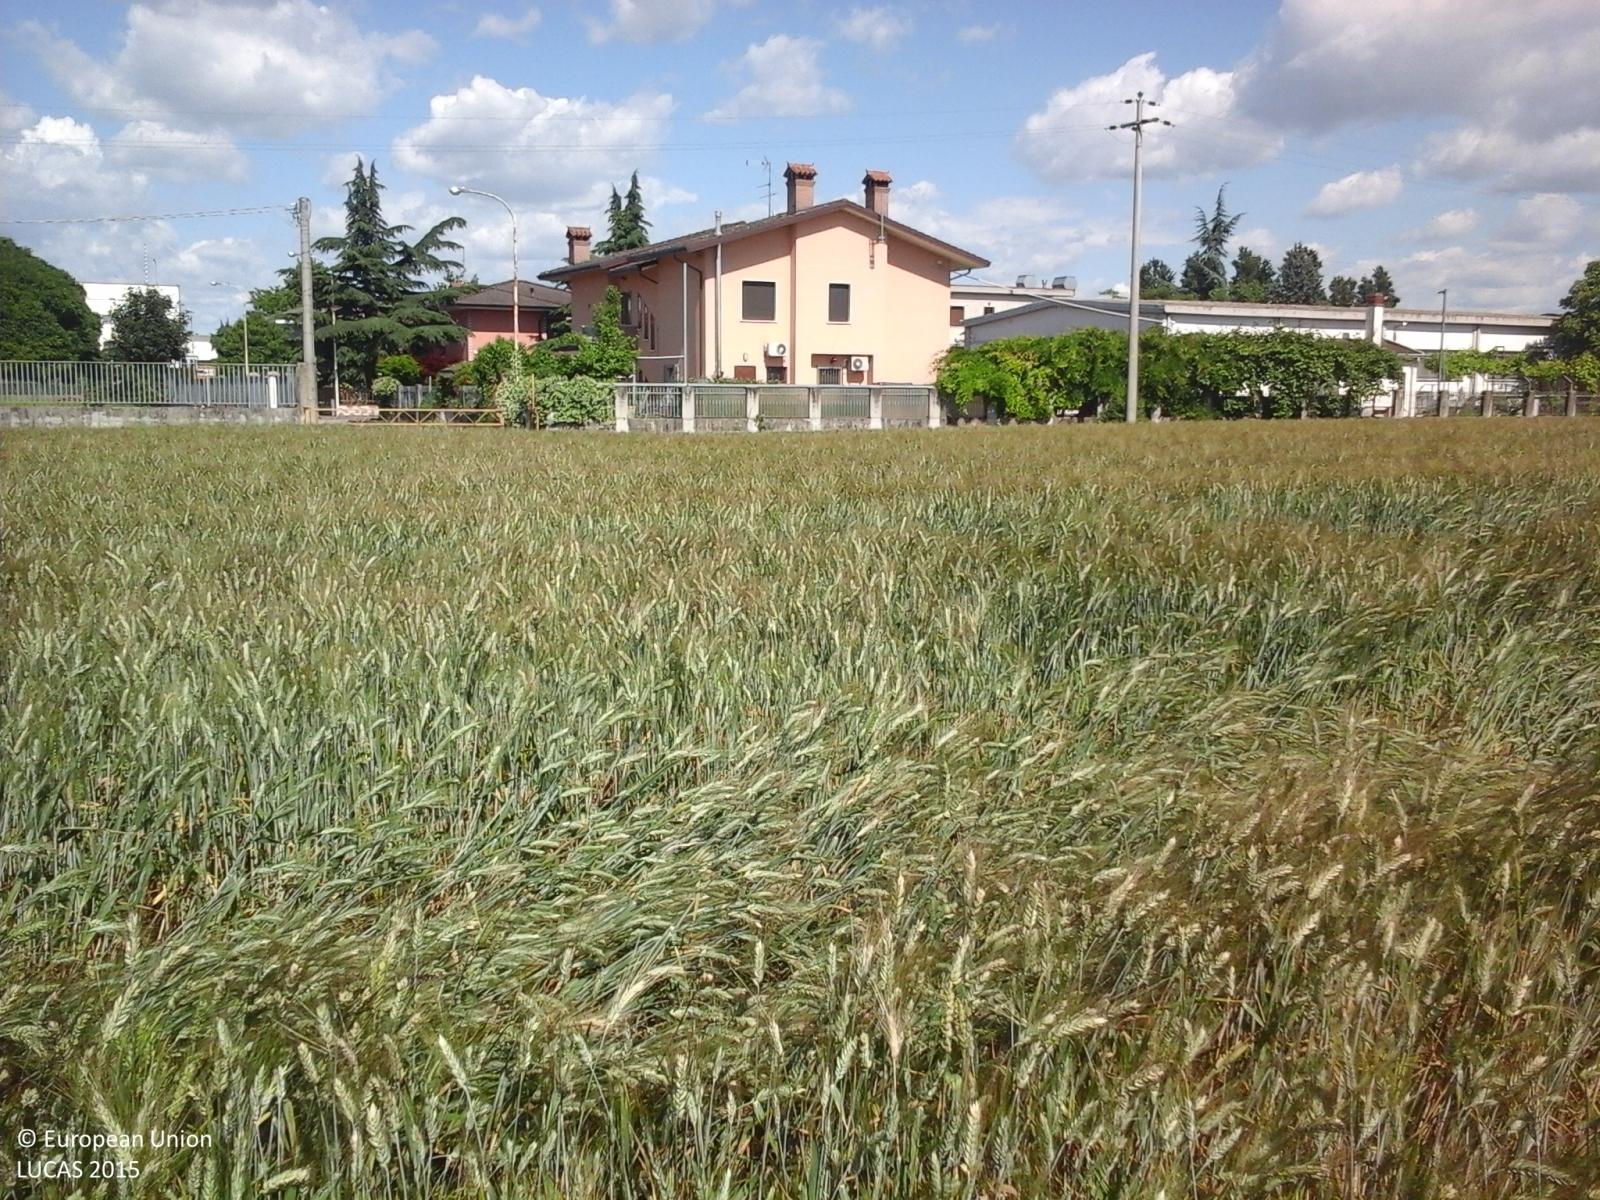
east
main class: Cropland
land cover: Common wheat
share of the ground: > 75 %
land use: Agriculture (excluding fallow land and kitchen gardens)
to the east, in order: Common wheat; Artificial constructions in urban areas
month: May
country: IT
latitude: 45.1381
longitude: 11.1043
